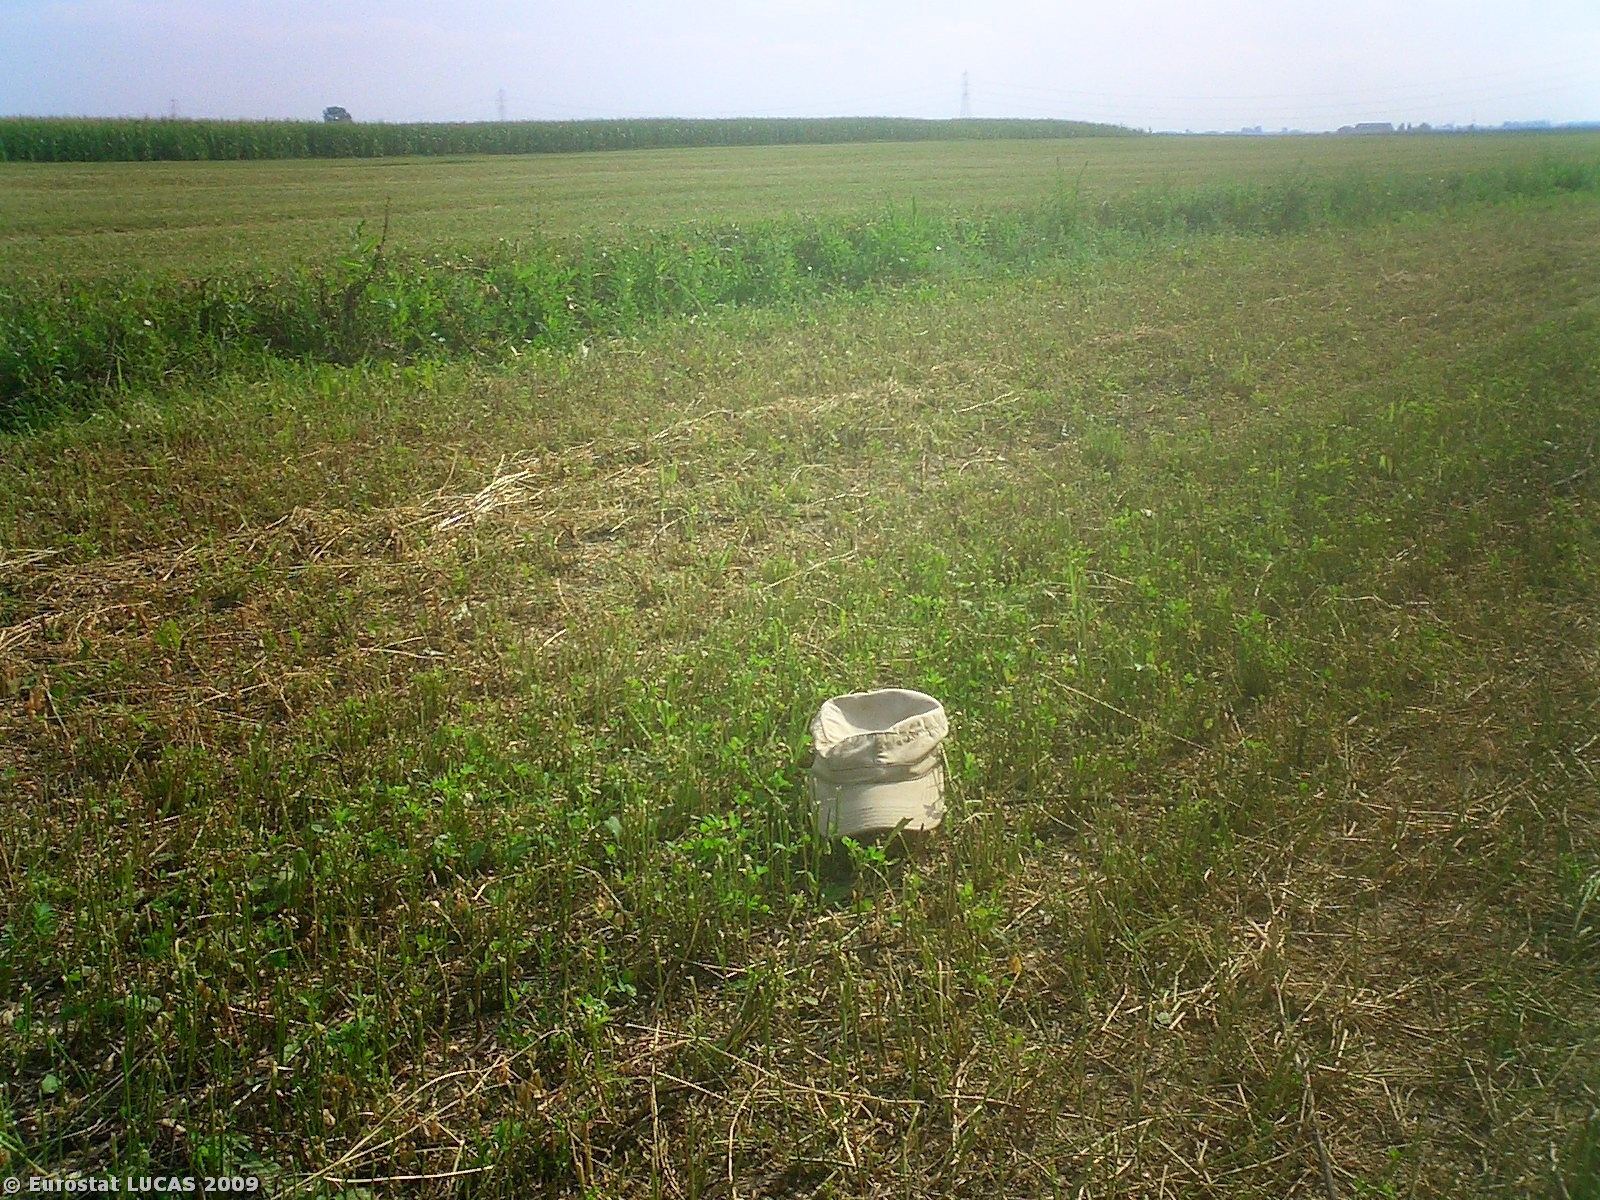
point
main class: Cropland
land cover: Lucerne
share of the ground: > 75 %
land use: Agriculture (excluding fallow land and kitchen gardens)
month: July
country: IT
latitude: 44.7992
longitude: 12.0566
